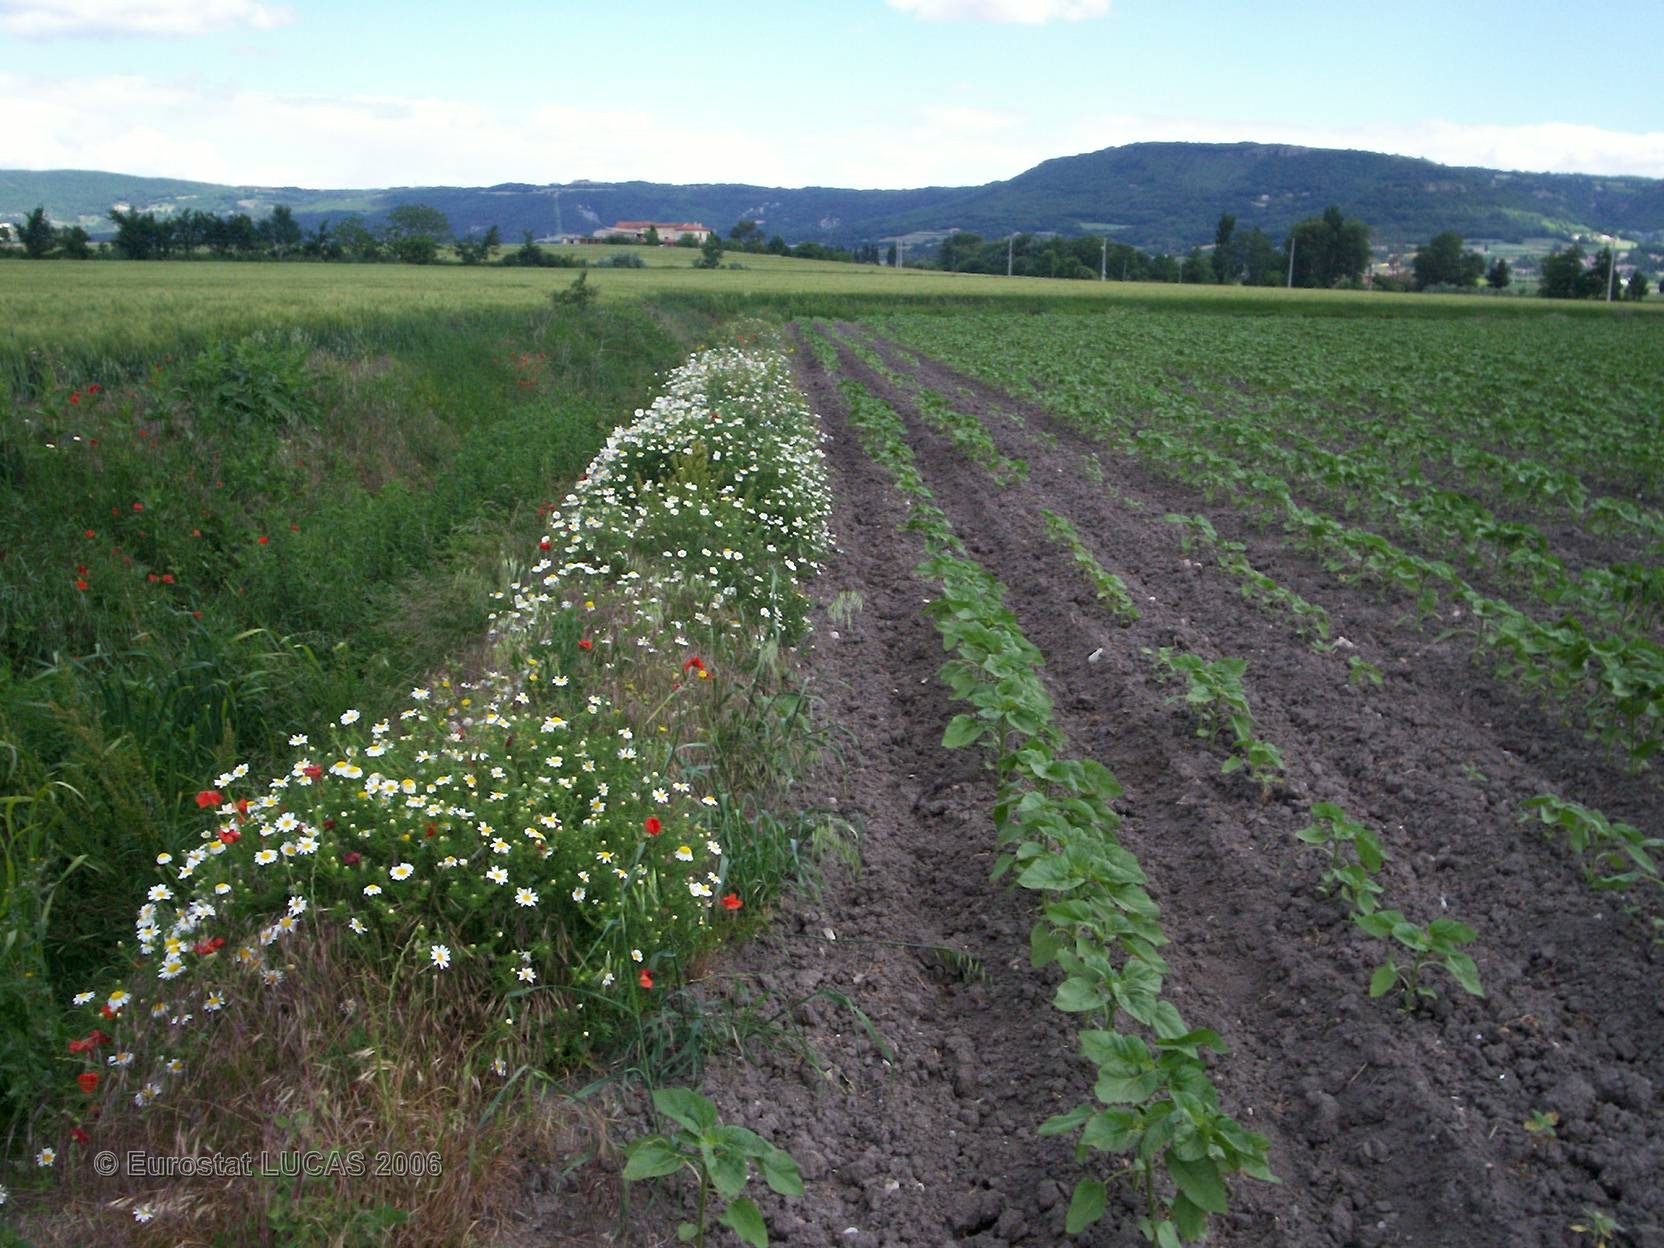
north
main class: Cropland
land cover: Durum wheat
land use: Agriculture (excluding fallow land and kitchen gardens)
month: May
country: FR
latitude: 44.6240
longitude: 4.9273
